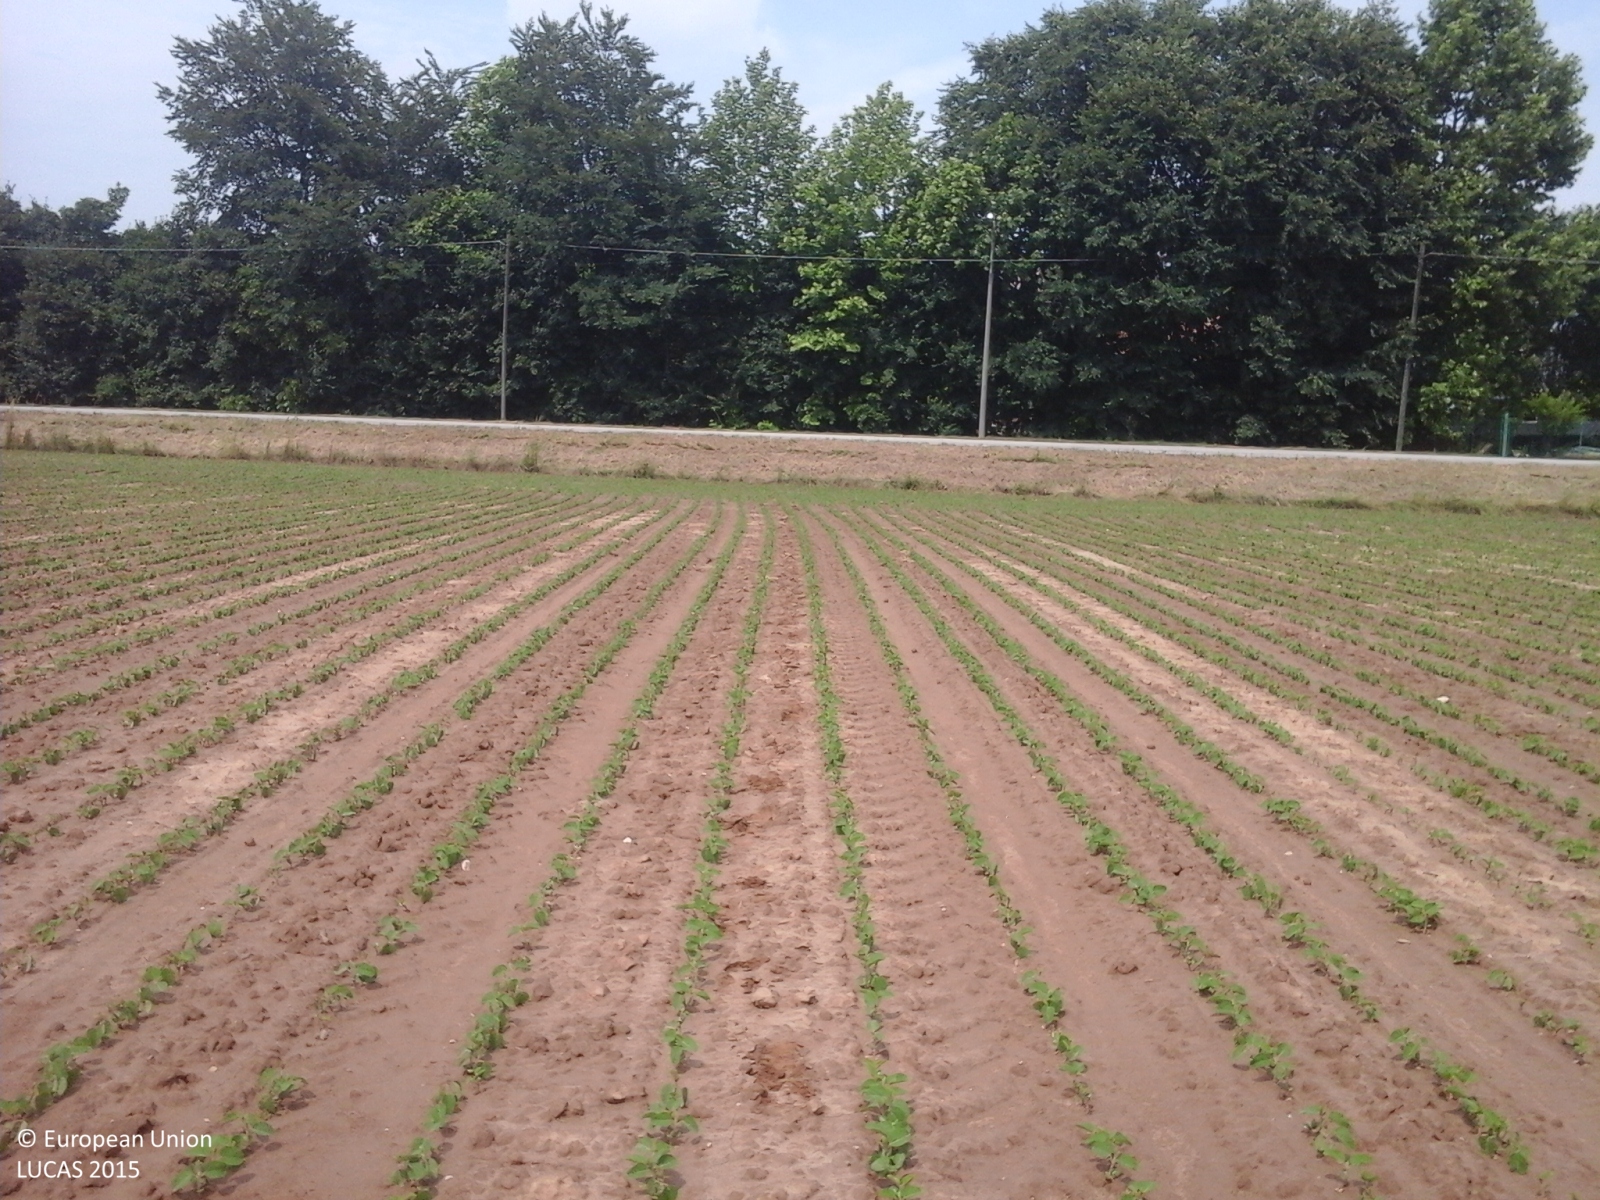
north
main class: Cropland
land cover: Soya
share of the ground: < 10 %
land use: Agriculture (excluding fallow land and kitchen gardens)
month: May
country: IT
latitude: 45.4559
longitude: 11.6213
